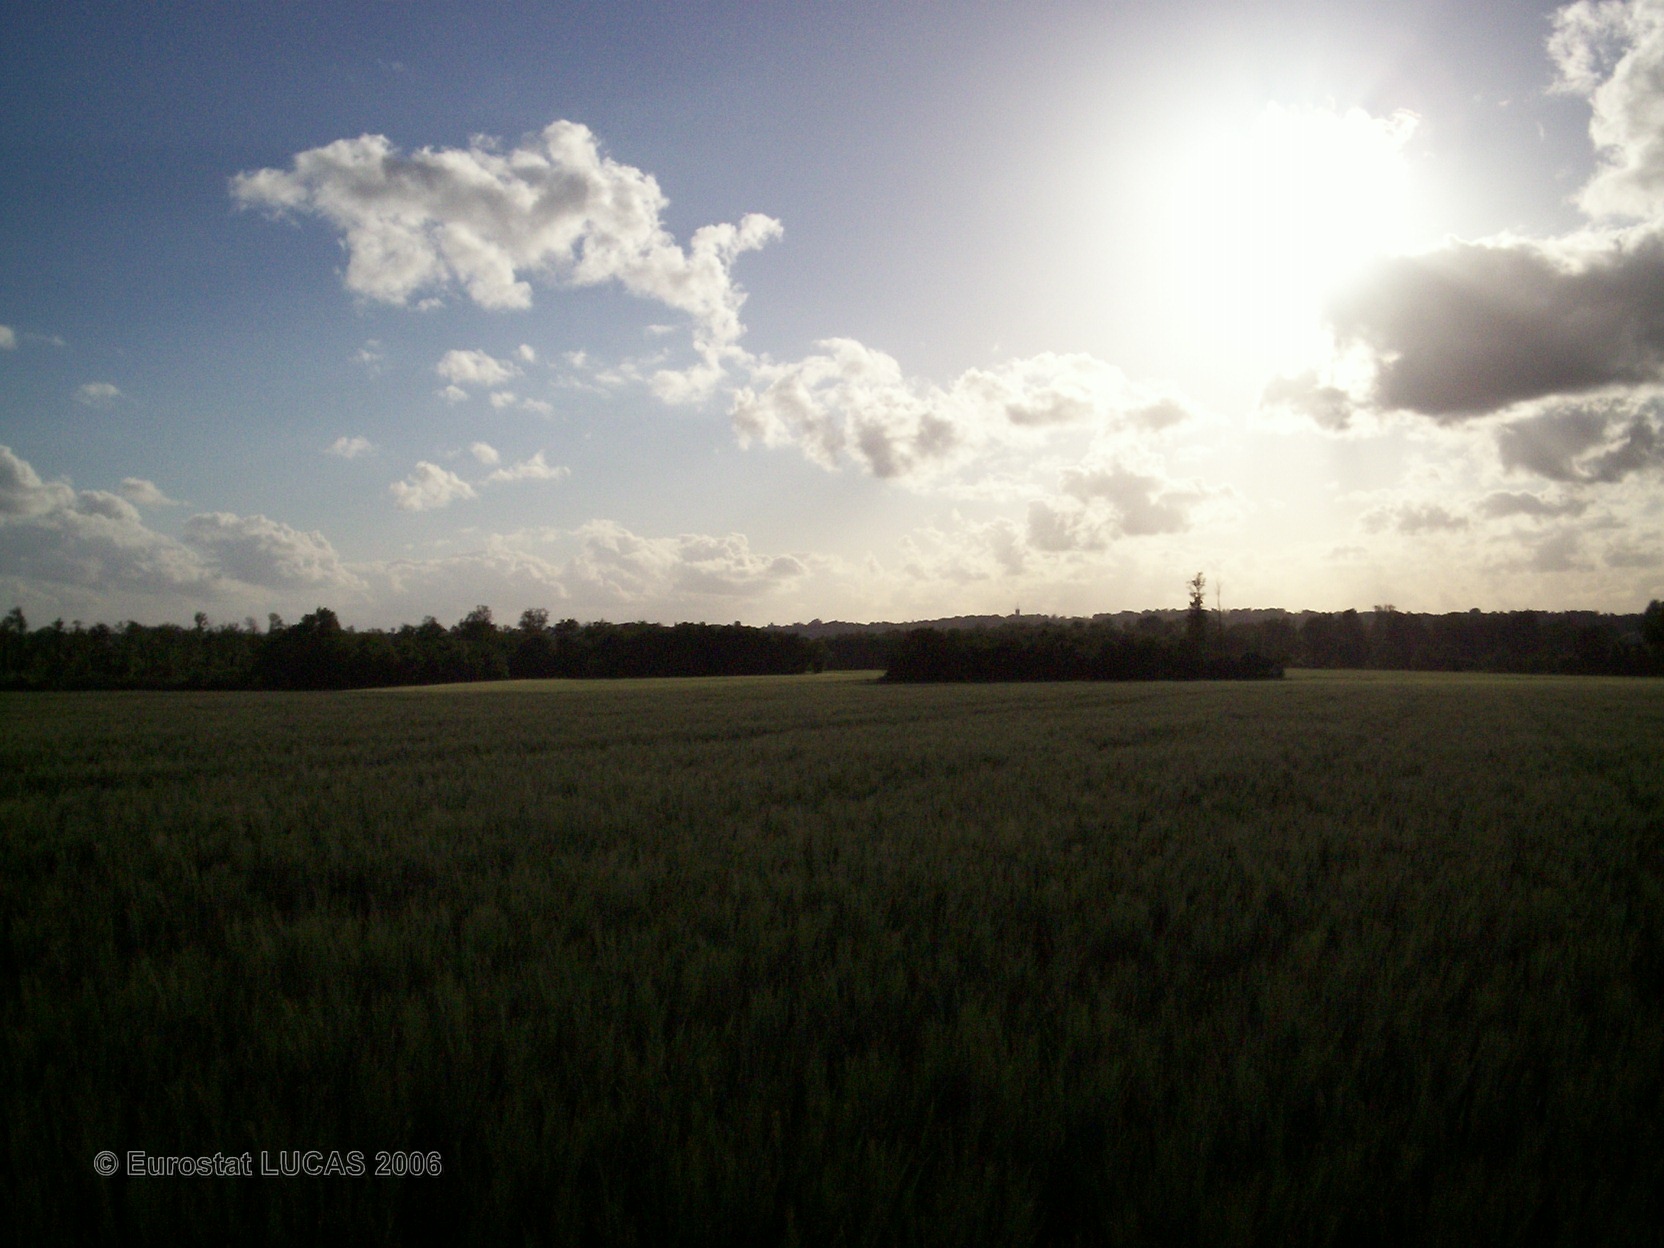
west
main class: Cropland
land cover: Durum wheat
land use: Agriculture (excluding fallow land and kitchen gardens)
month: May
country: FR
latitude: 45.8164
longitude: 0.4745
